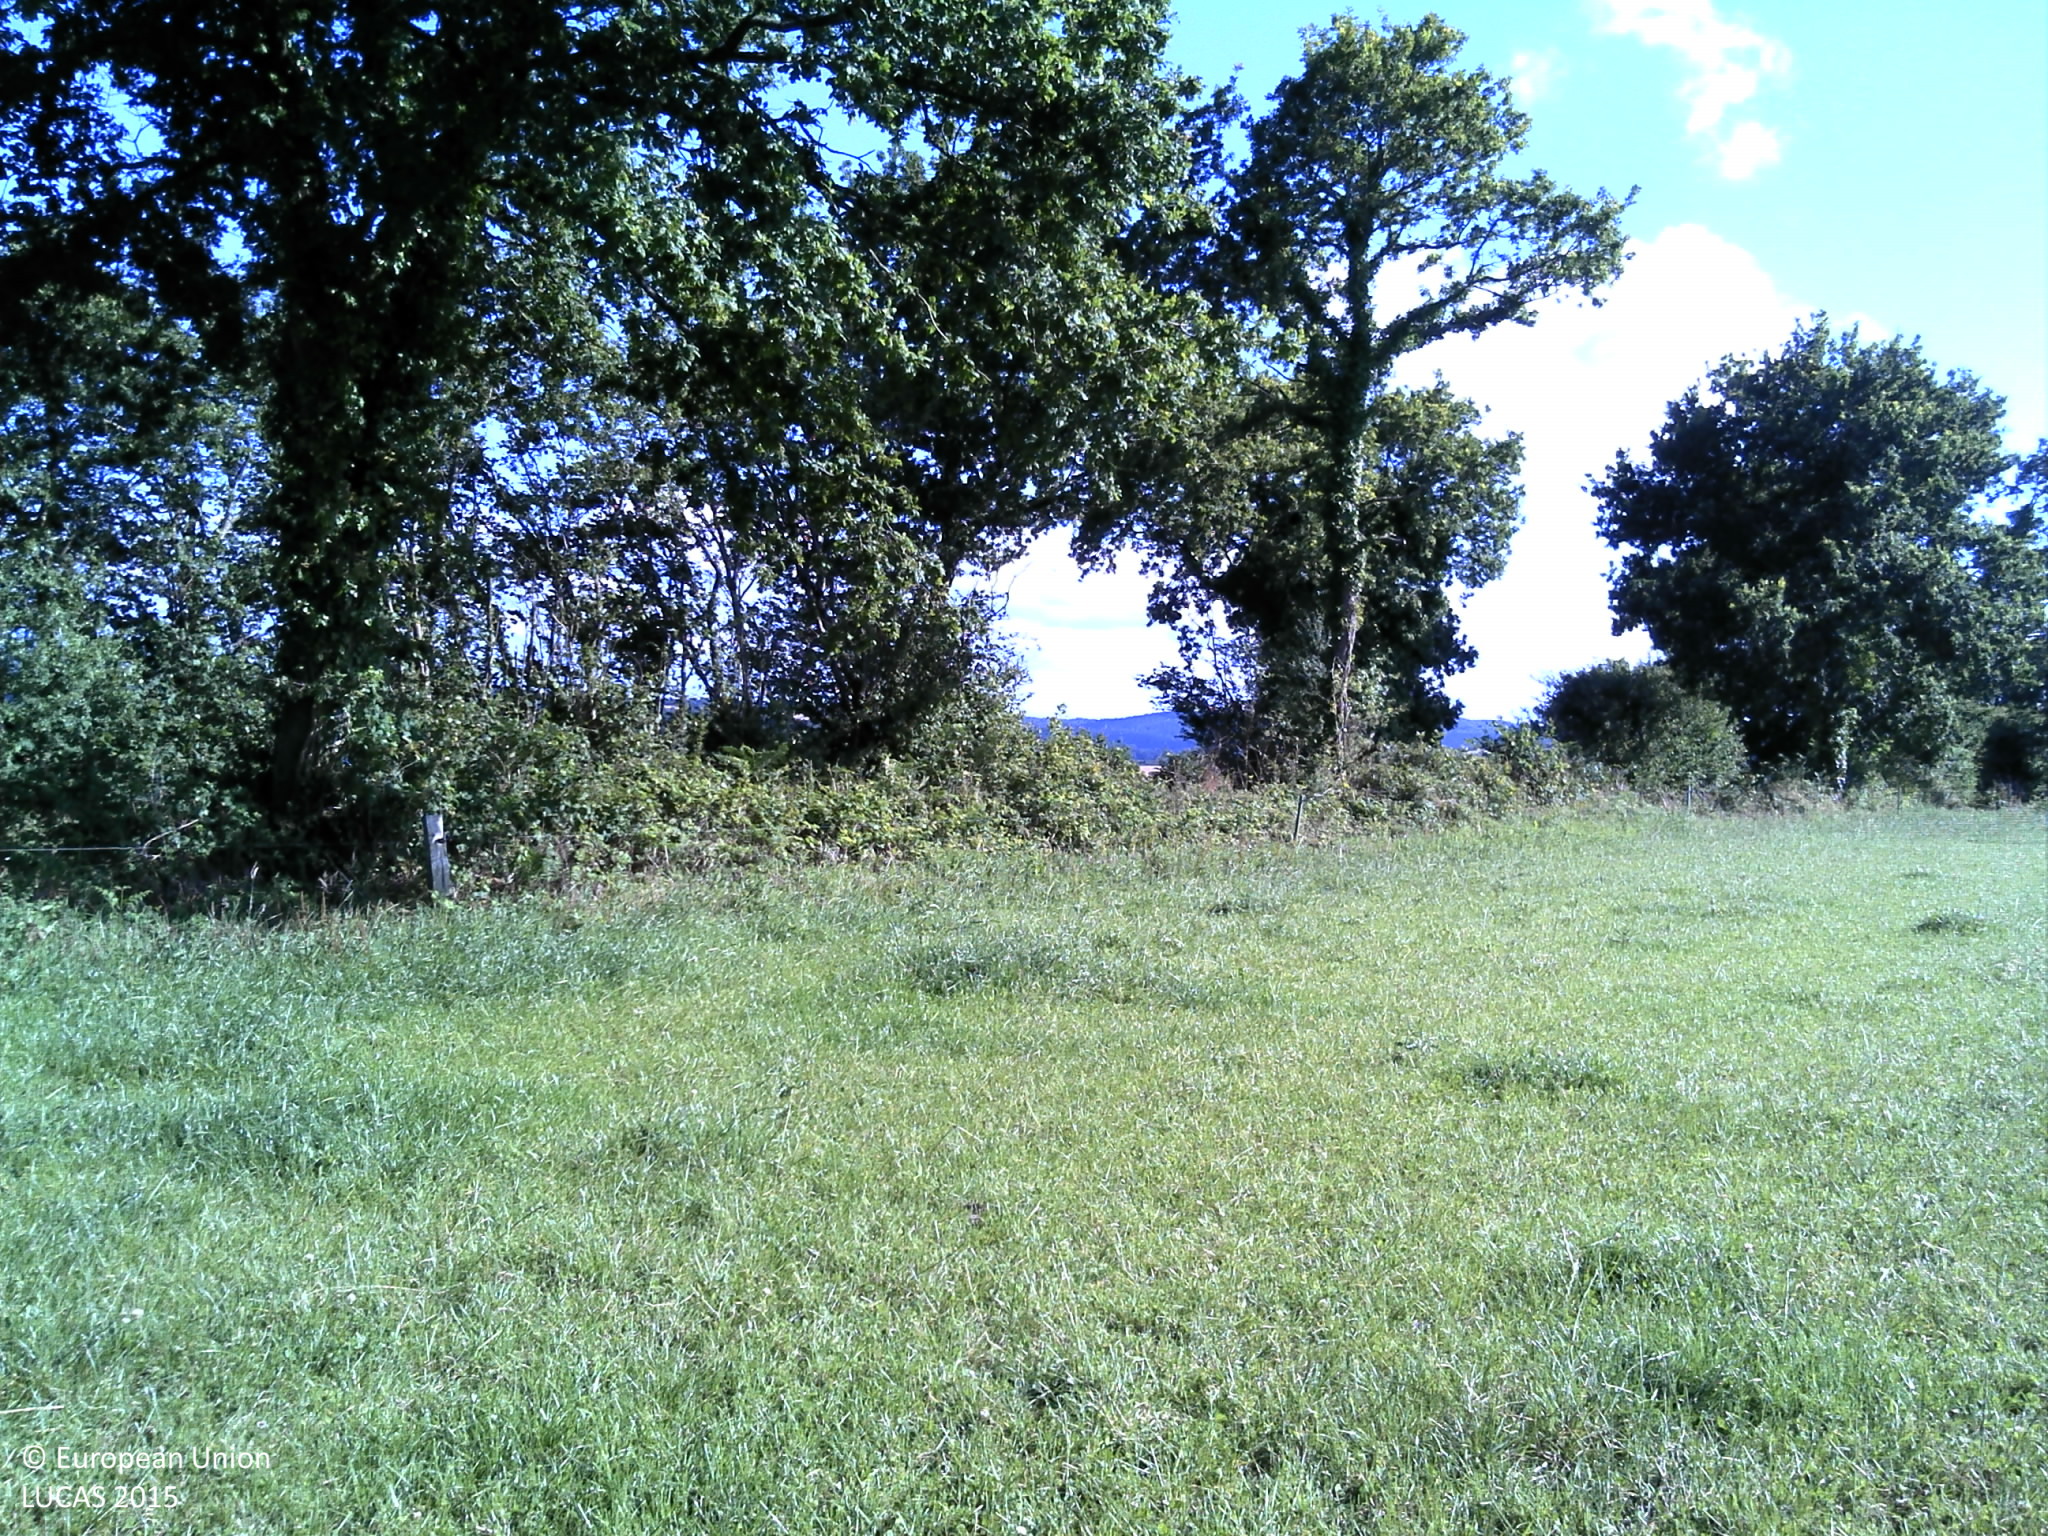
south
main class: Grassland
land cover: Grassland without tree/shrub cover
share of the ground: > 75 %
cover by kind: herbaceous plants 100 %
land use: Agriculture (excluding fallow land and kitchen gardens)
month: July
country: FR
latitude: 48.4724
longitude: -3.7314
